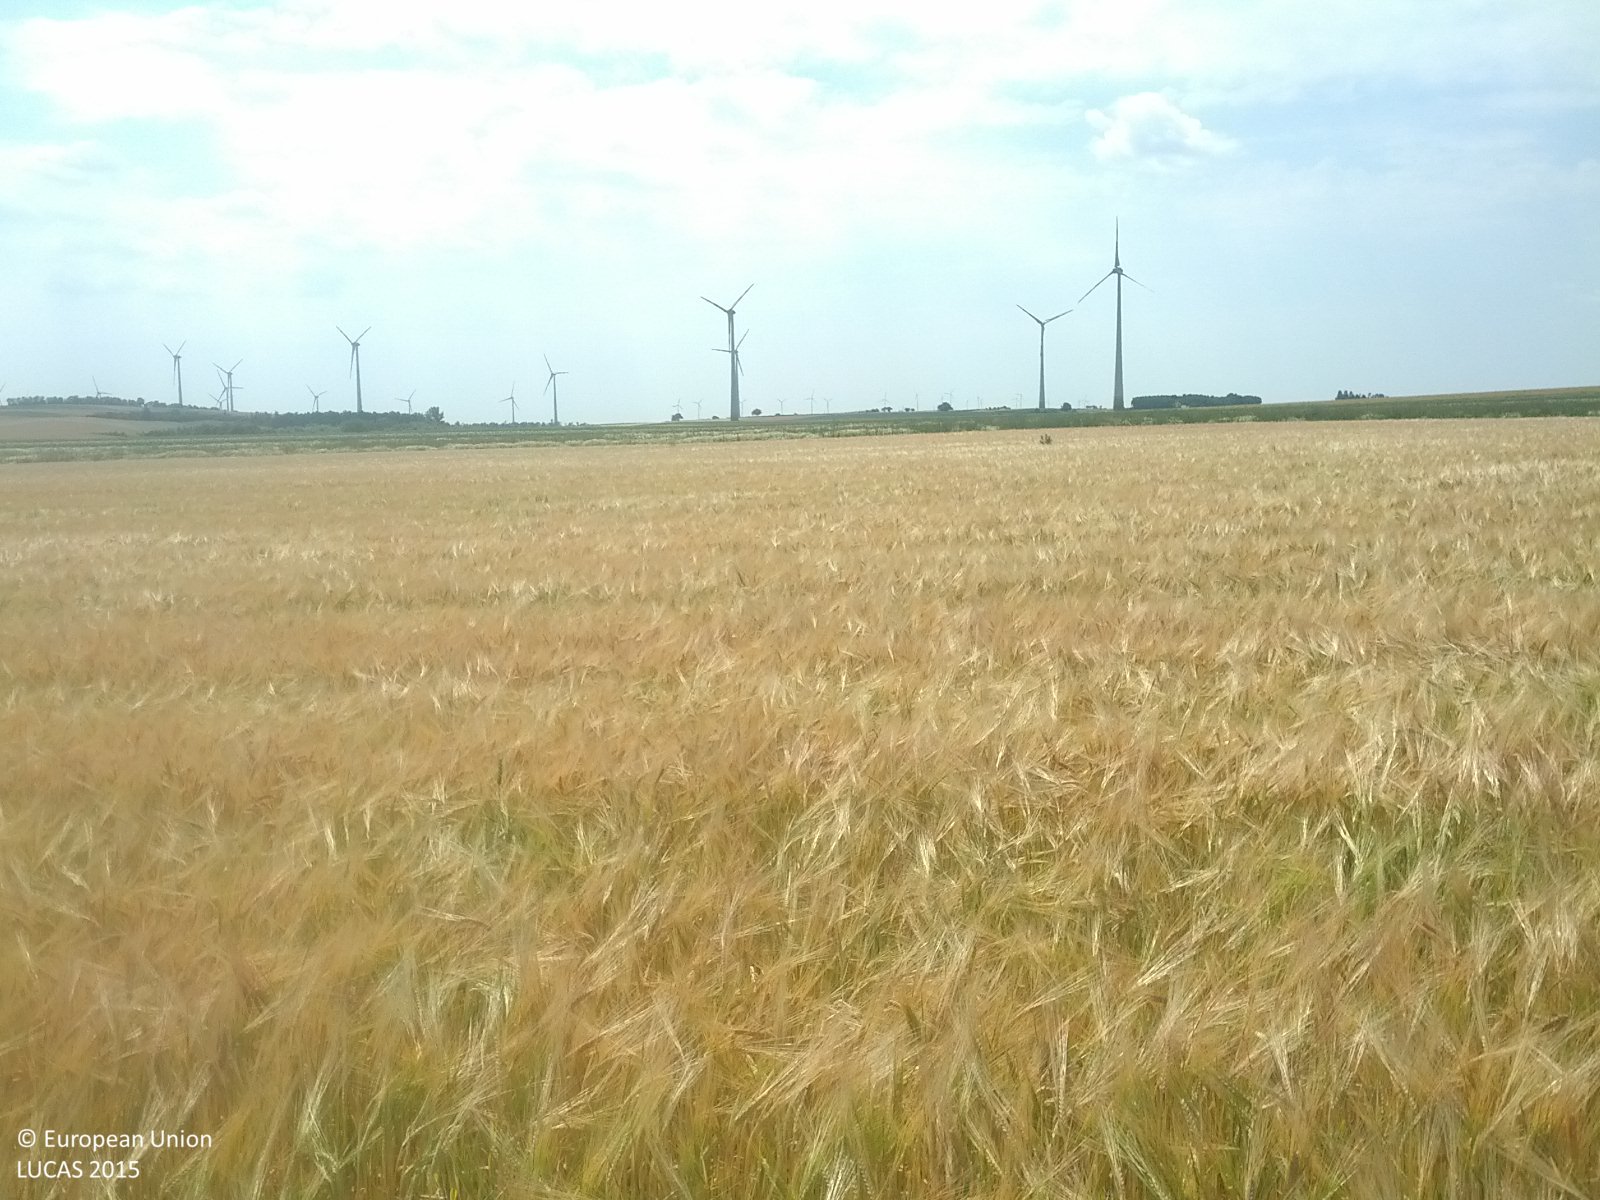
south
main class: Cropland
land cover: Barley
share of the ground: > 75 %
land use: Agriculture (excluding fallow land and kitchen gardens)
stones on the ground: < 10 %
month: July
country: AT
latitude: 48.6662
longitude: 16.7557
